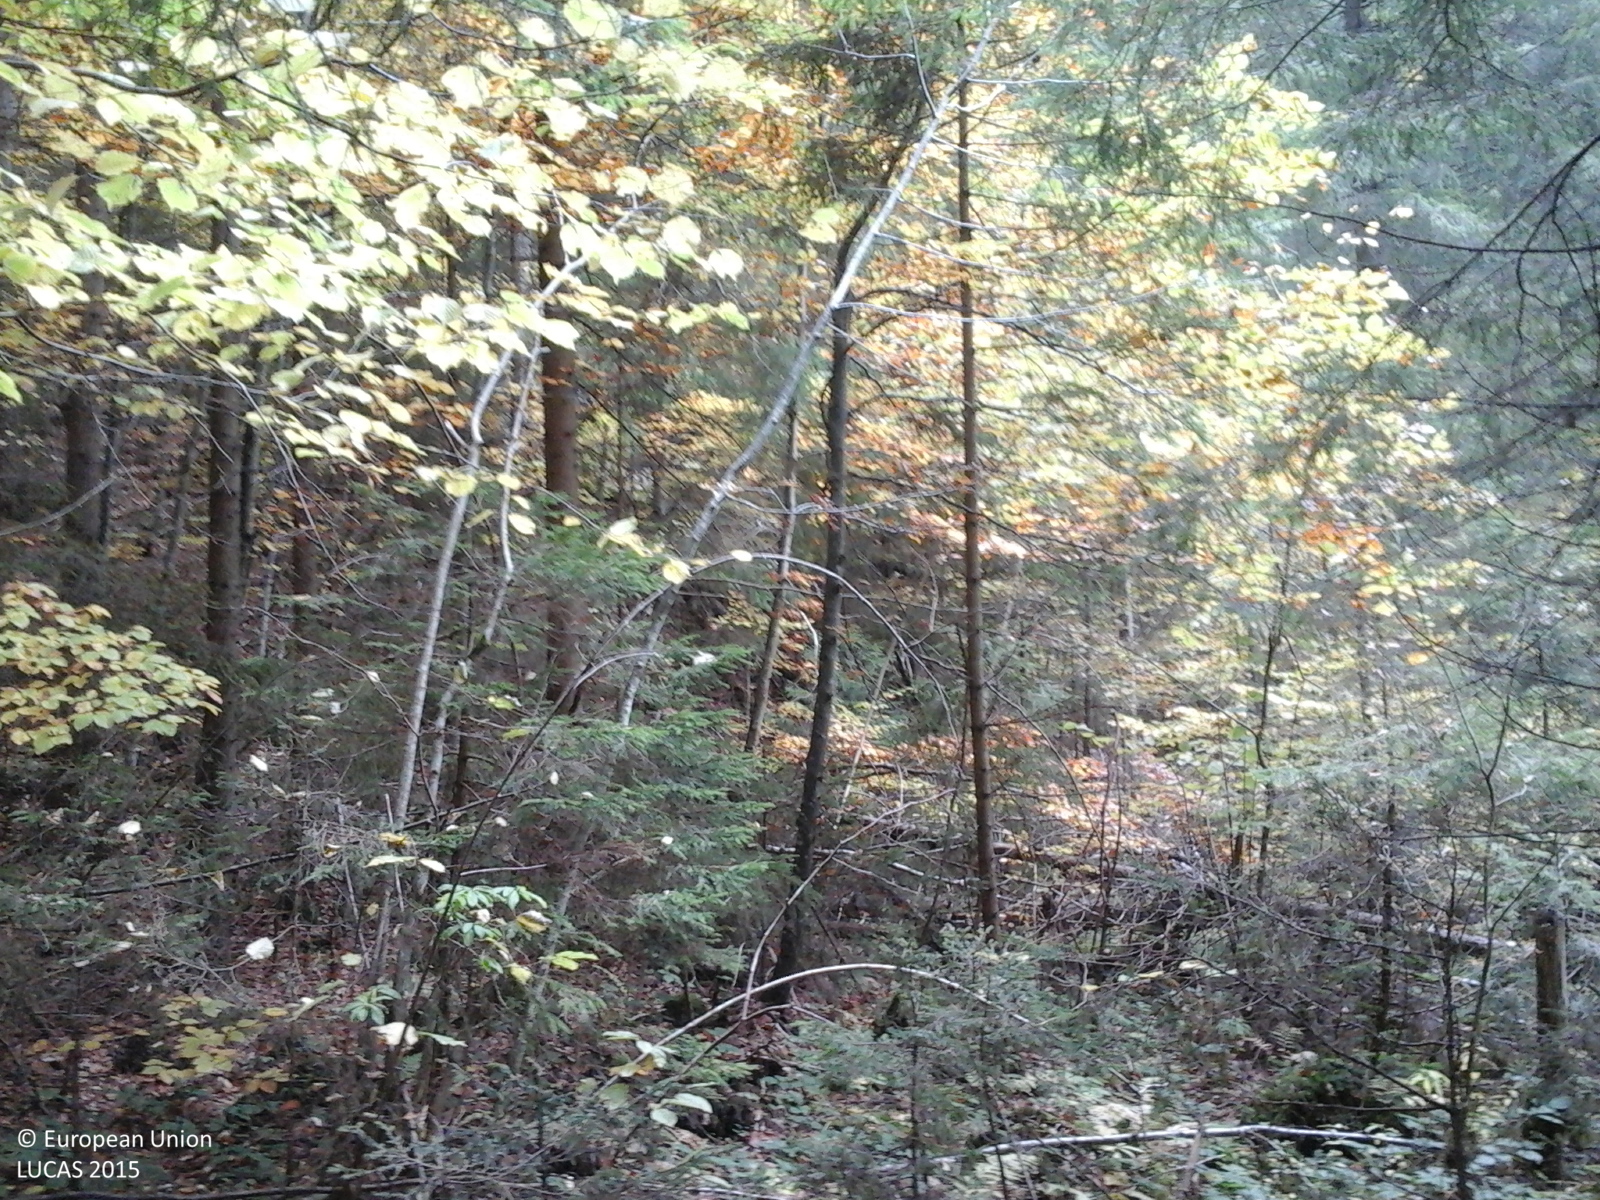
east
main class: Woodland
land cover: Spruce dominated mixed woodland
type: alpine coniferous forest
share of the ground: > 75 %
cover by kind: coniferous forest trees 60 %, broadleaved forest trees 40 %
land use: Forestry
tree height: > 5 m
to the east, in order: Spruce dominated mixed woodland; Tracks; Spruce dominated mixed woodland; Tracks; Spruce dominated mixed woodland
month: October
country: RO
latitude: 46.5562
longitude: 25.4608
